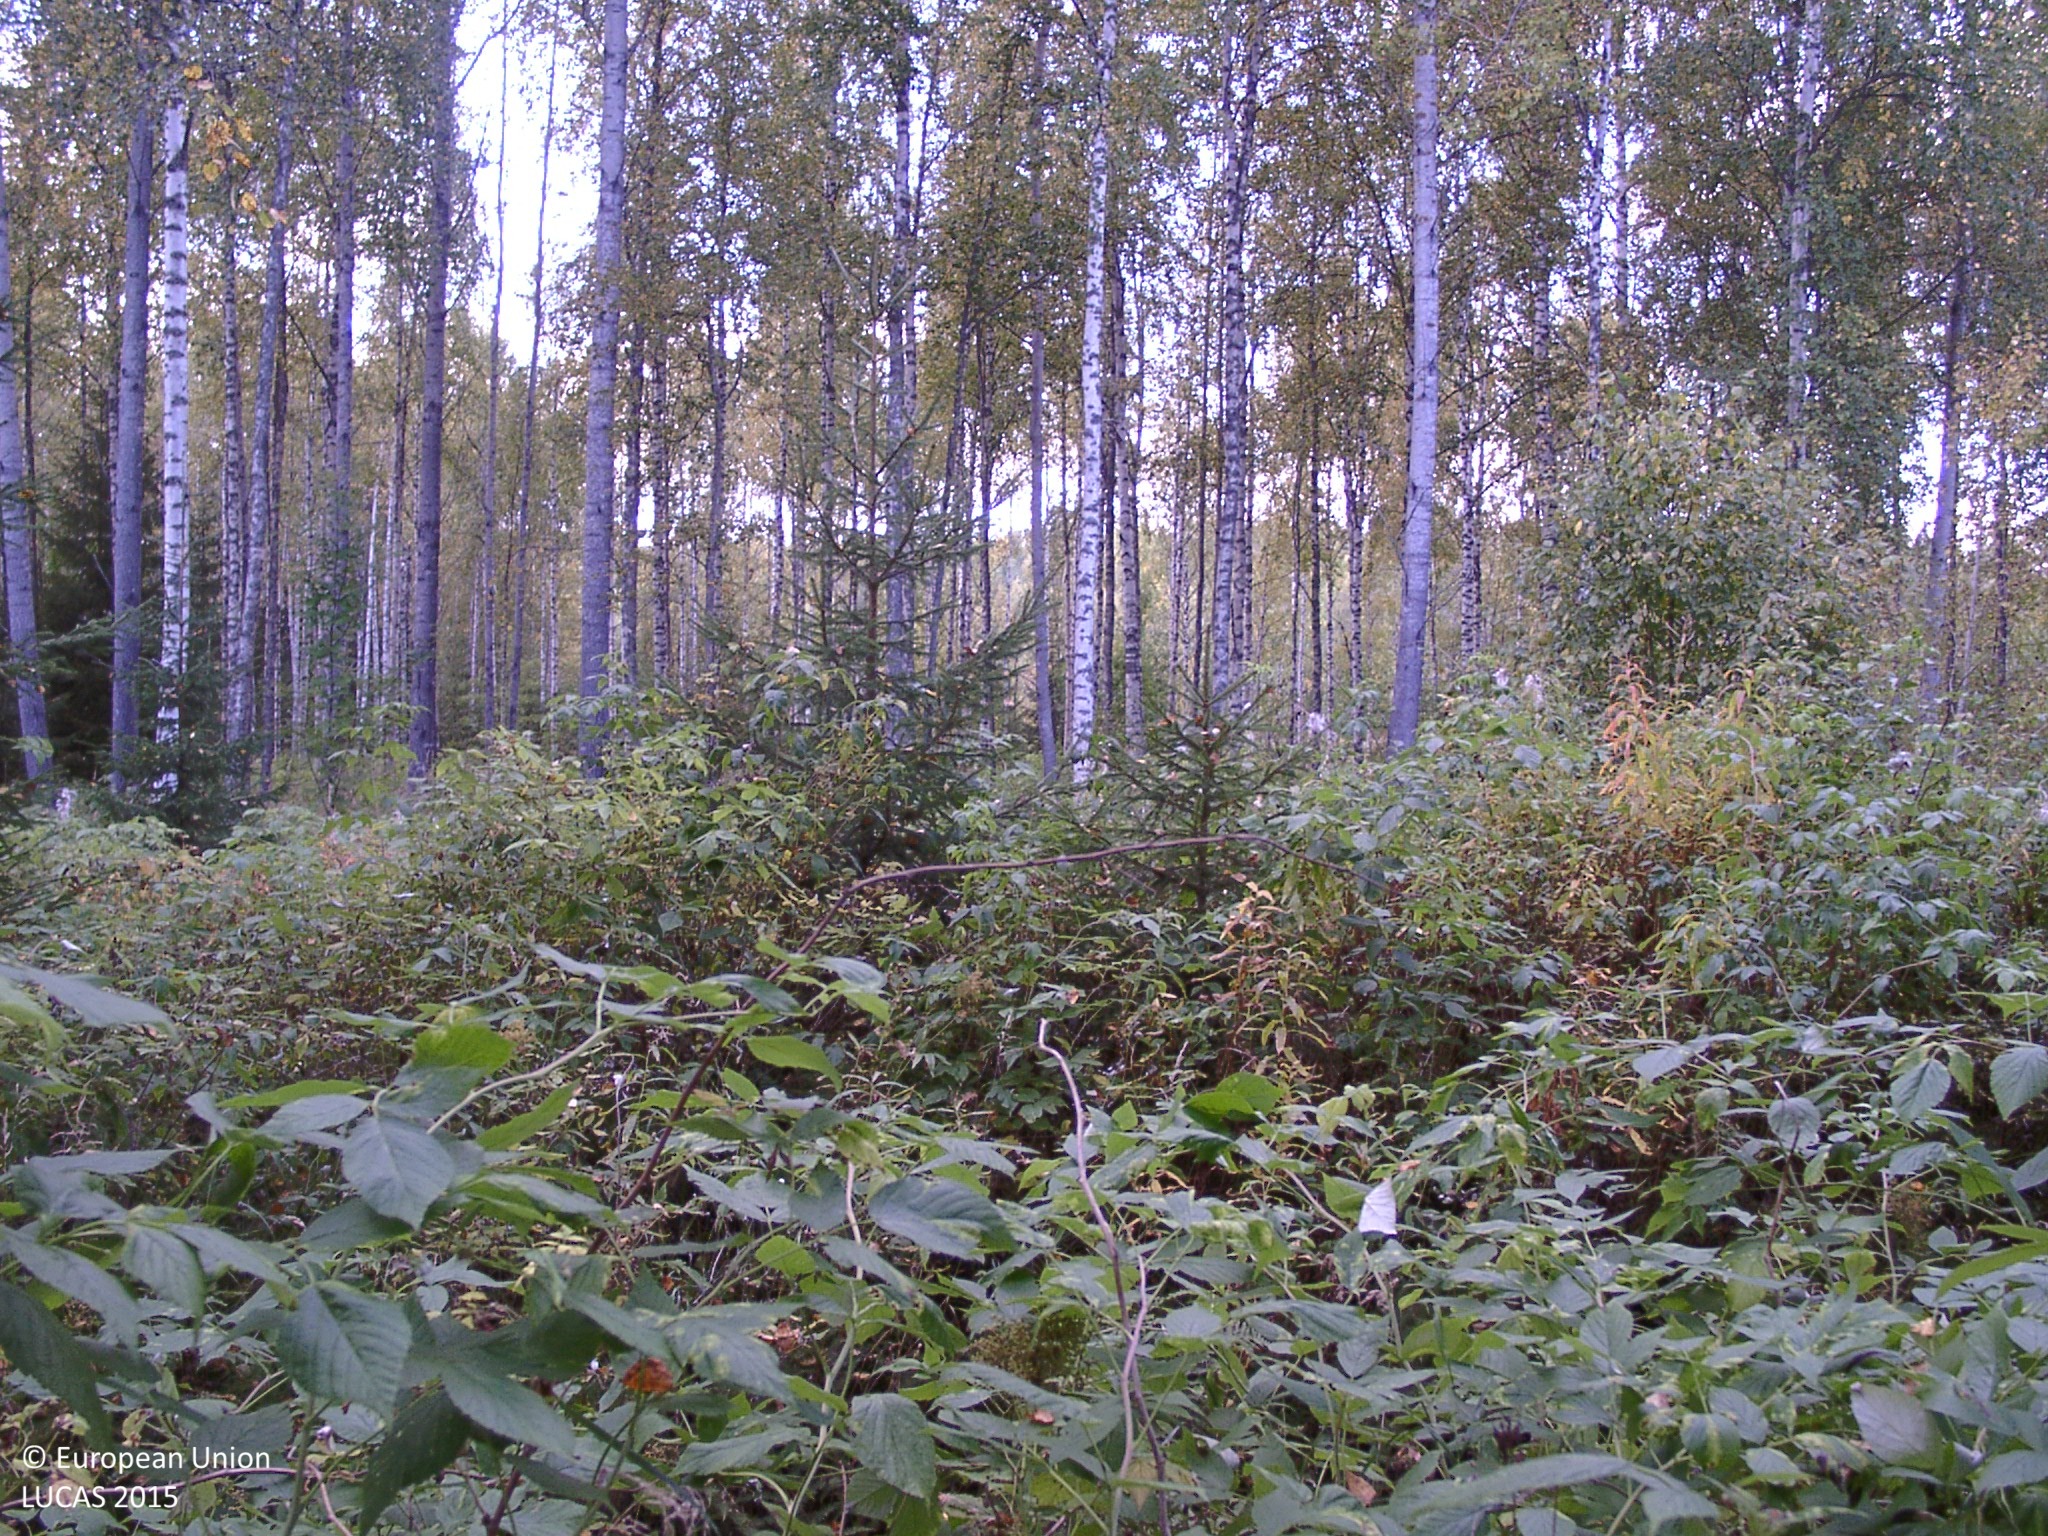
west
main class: Artificial land
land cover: Non built-up linear features
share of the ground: > 75 %
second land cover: Grassland without tree/shrub cover
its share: 50 - 75 %
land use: Road transport
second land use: Residential
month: September
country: FI
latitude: 62.4907
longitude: 25.6206
